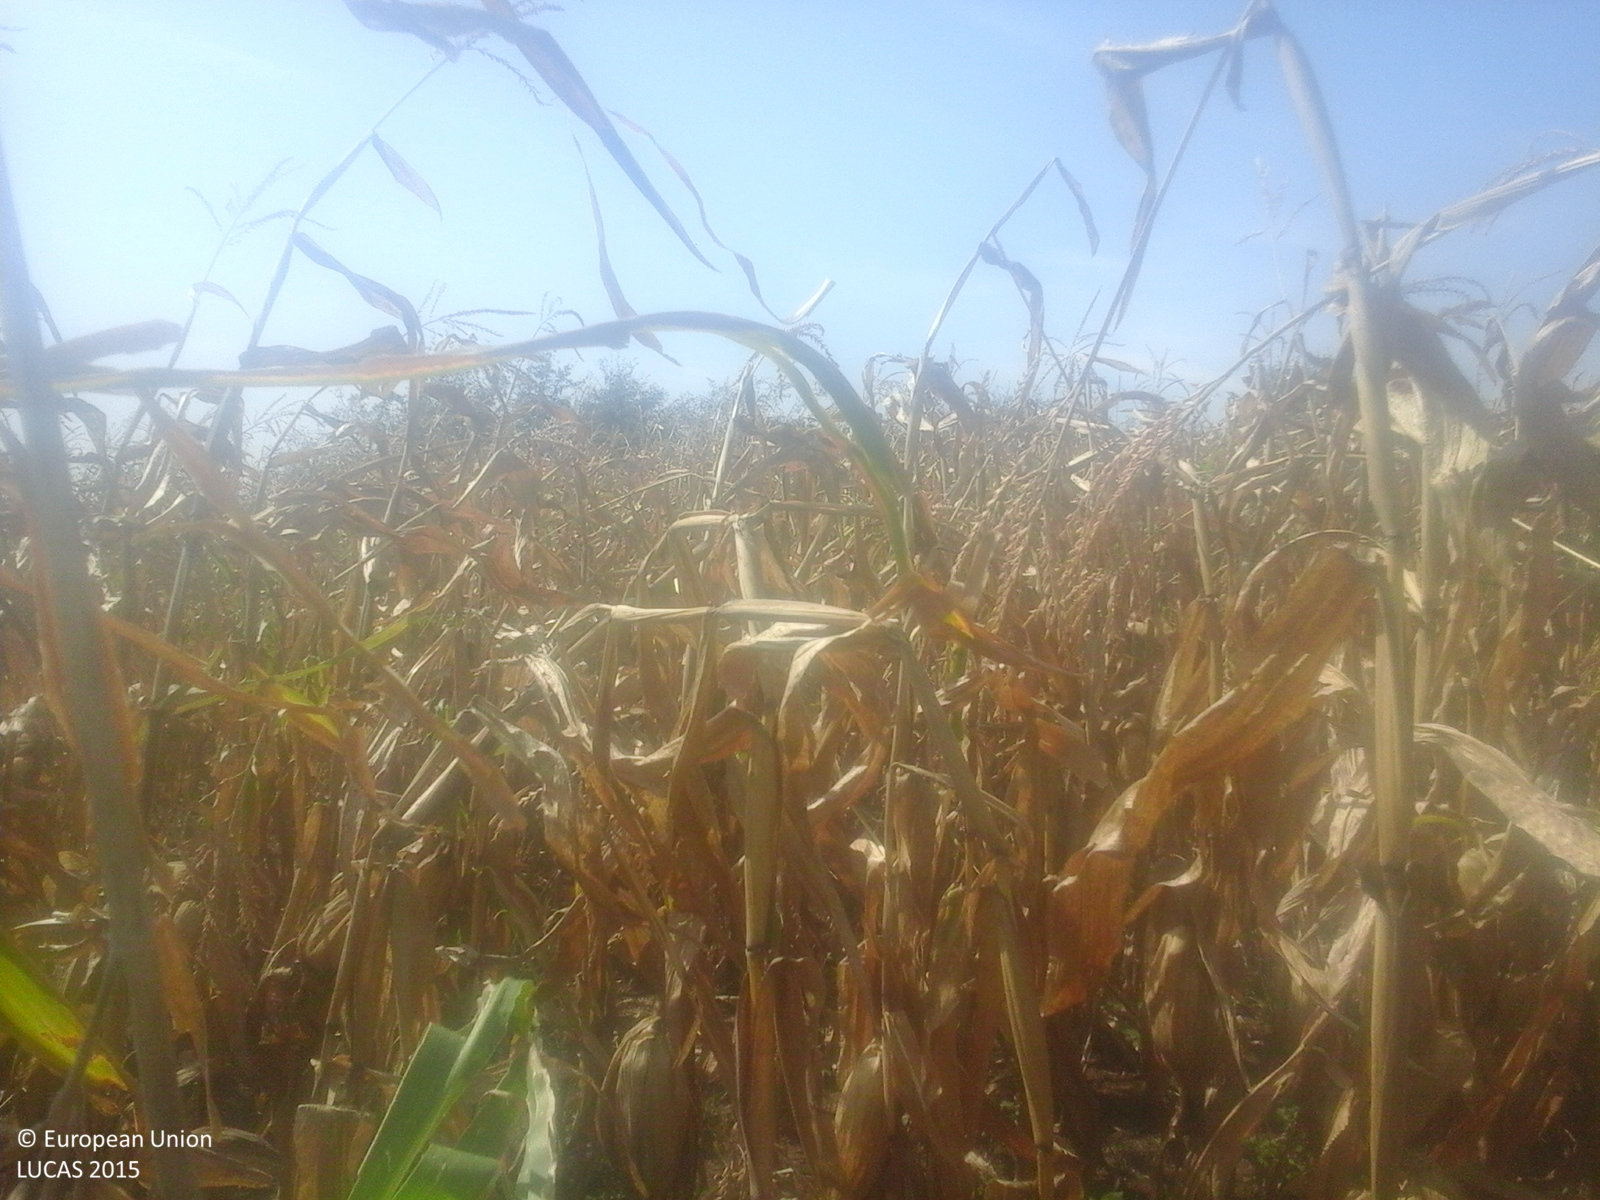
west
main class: Cropland
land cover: Maize
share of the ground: > 75 %
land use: Agriculture (excluding fallow land and kitchen gardens)
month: September
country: RO
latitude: 46.9614
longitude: 23.7022
